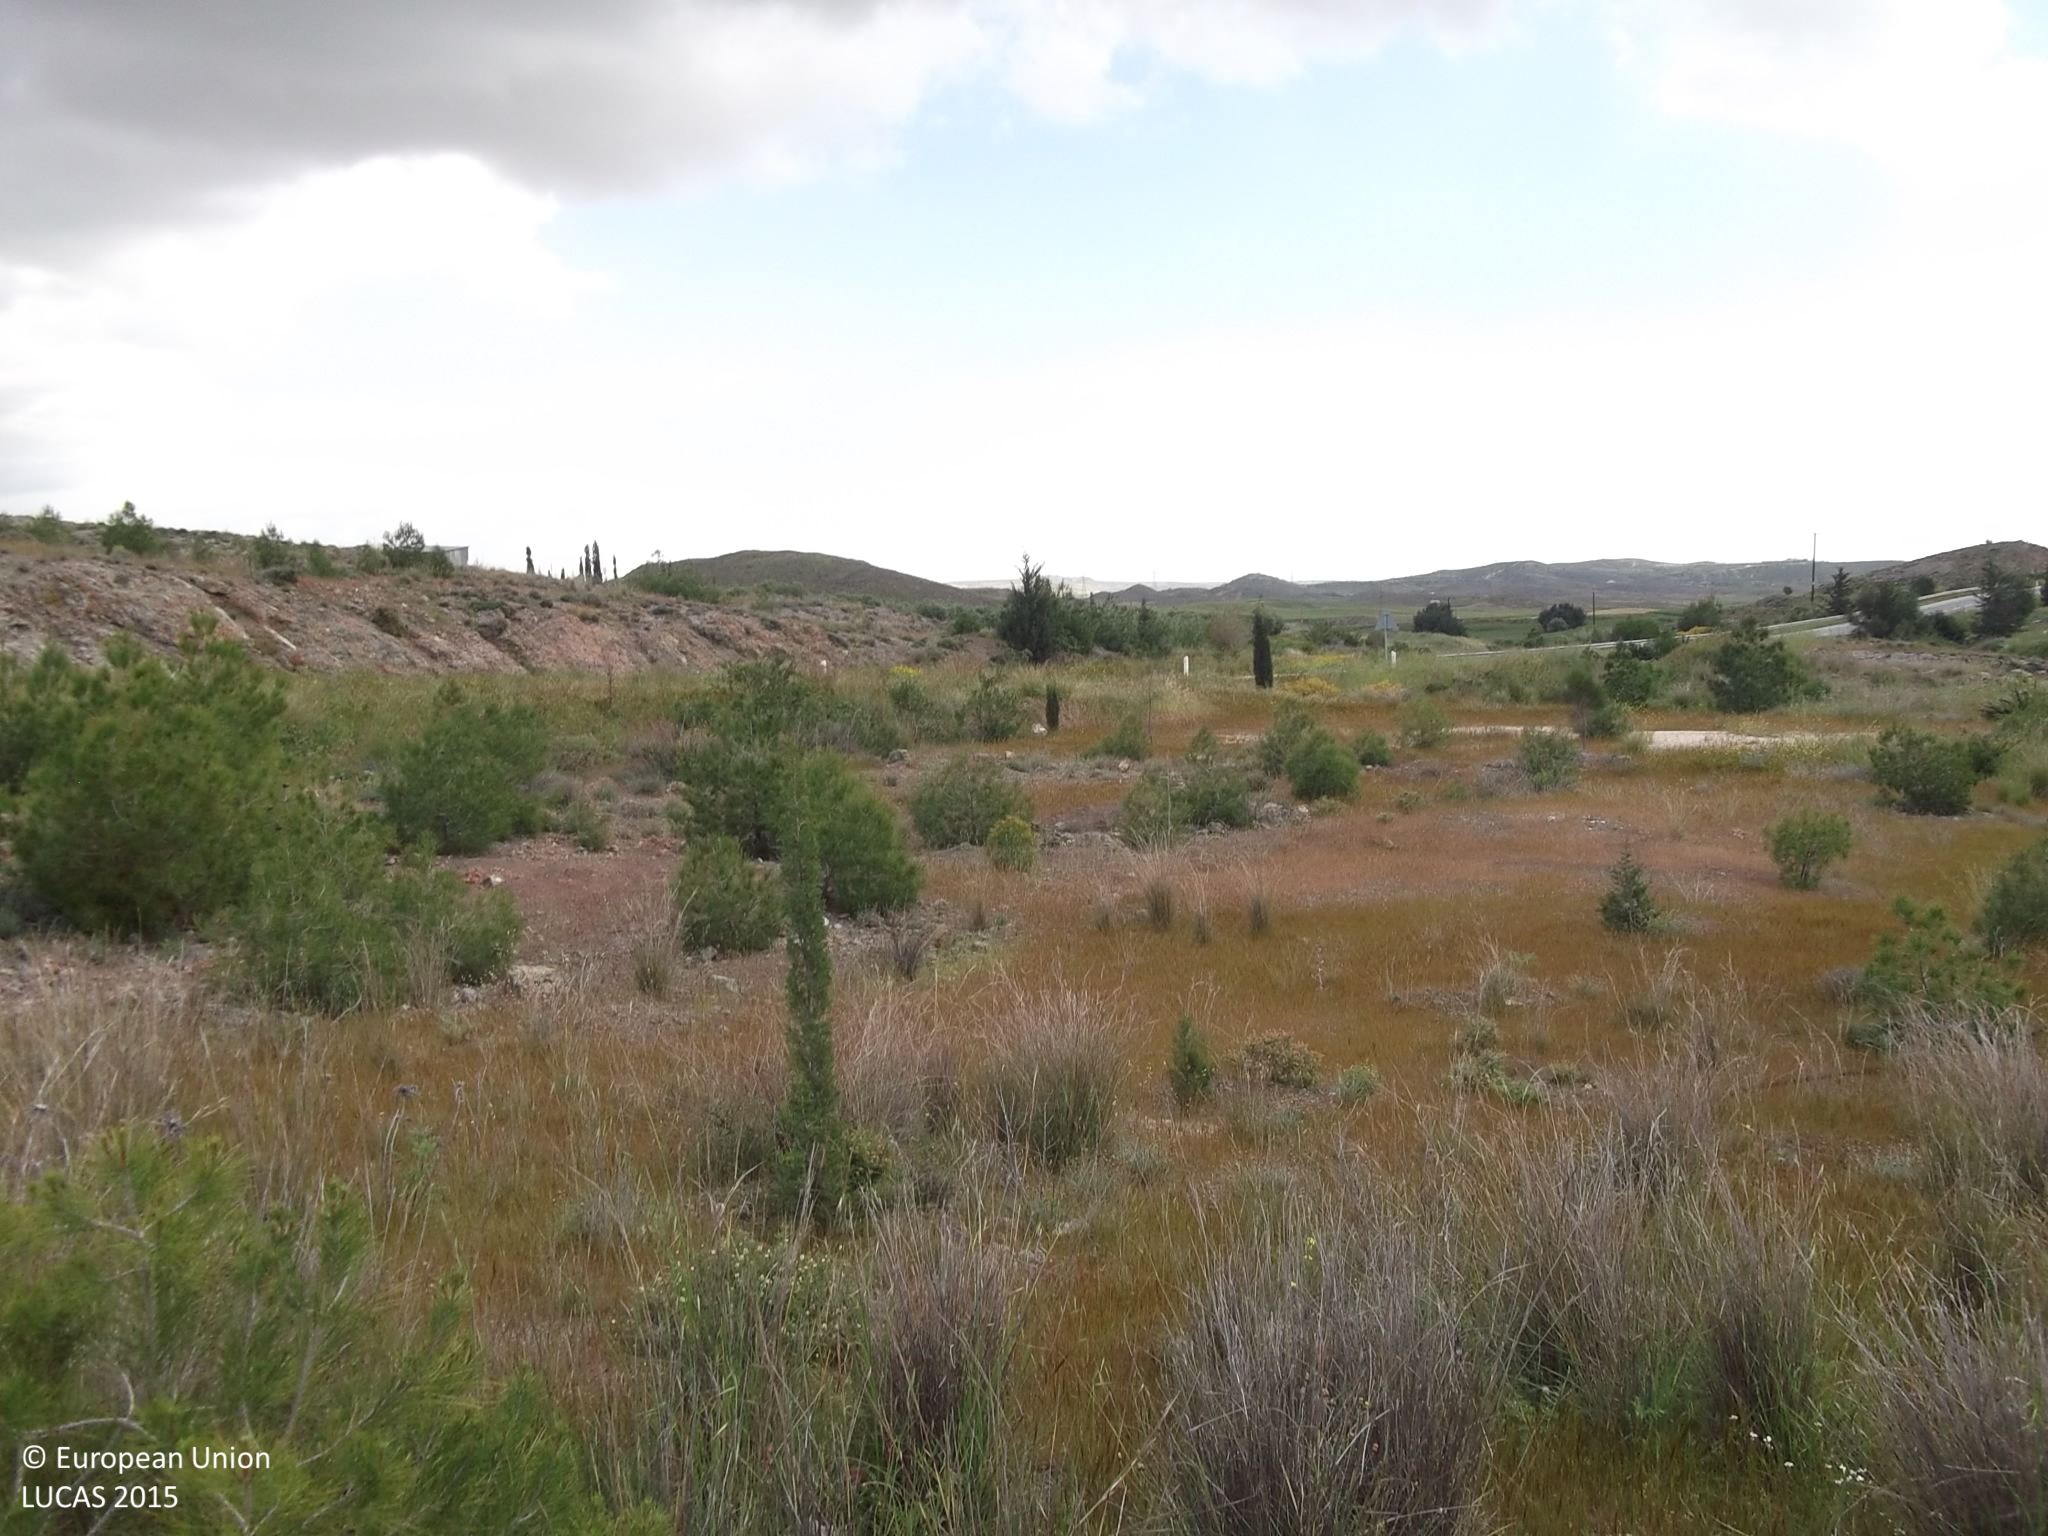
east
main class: Shrubland
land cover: Shrubland with sparse tree cover
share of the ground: 50 - 75 %
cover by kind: shrubs 55 %, herbaceous plants 30 %, consolidated bare surface 10 %, coniferous forest trees 5 %
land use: Semi-natural and natural areas not in use
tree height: < 5 m
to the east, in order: Shrubland with sparse tree cover; Abandoned hedges; Paved roads, cycling and walking lanes; Shrubland without tree cover; Rock outcrops; Tracks; Olive groves; Spontaneously vegetated surfaces
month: April
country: CY
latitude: 35.0034
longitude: 33.5686
